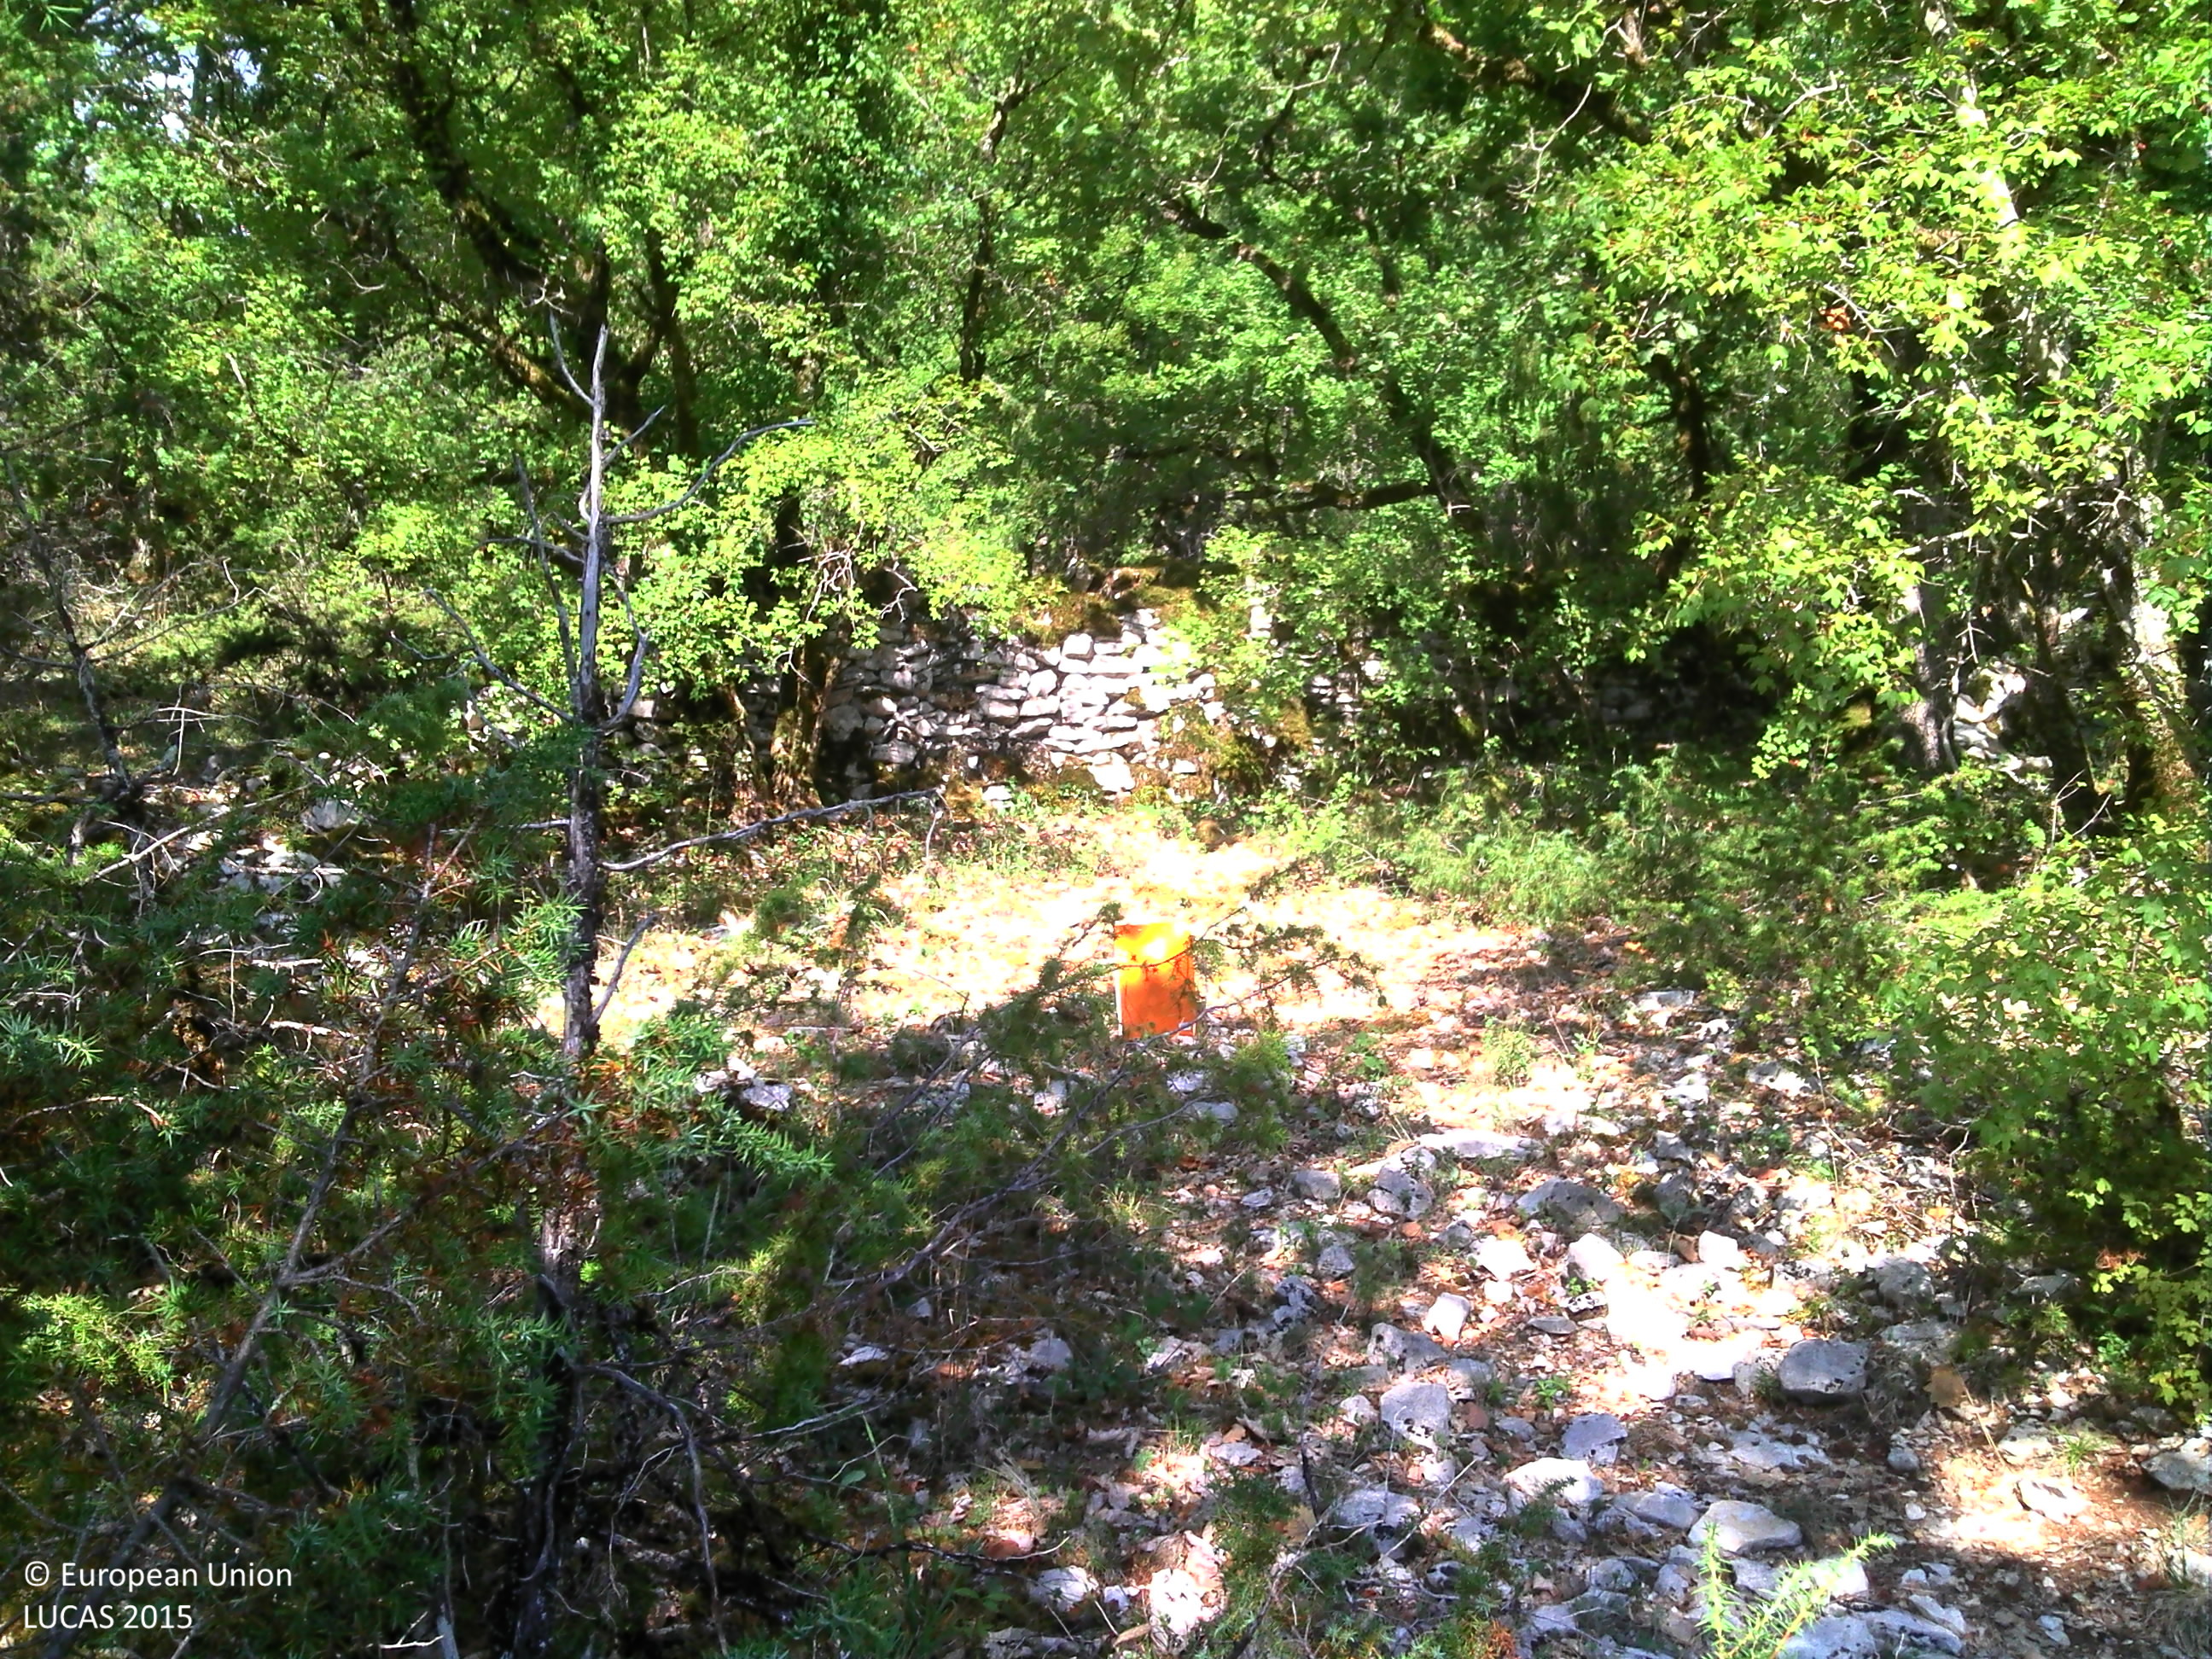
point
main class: Woodland
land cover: Broadleaved woodland
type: thermophilous deciduous forest
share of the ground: > 75 %
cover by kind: broadleaved forest trees 75 %, shrubs 10 %, unconsolidated bare surface 10 %, herbaceous plants 5 %
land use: Semi-natural and natural areas not in use
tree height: > 5 m
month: September
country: FR
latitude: 44.5892
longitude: 1.8244
